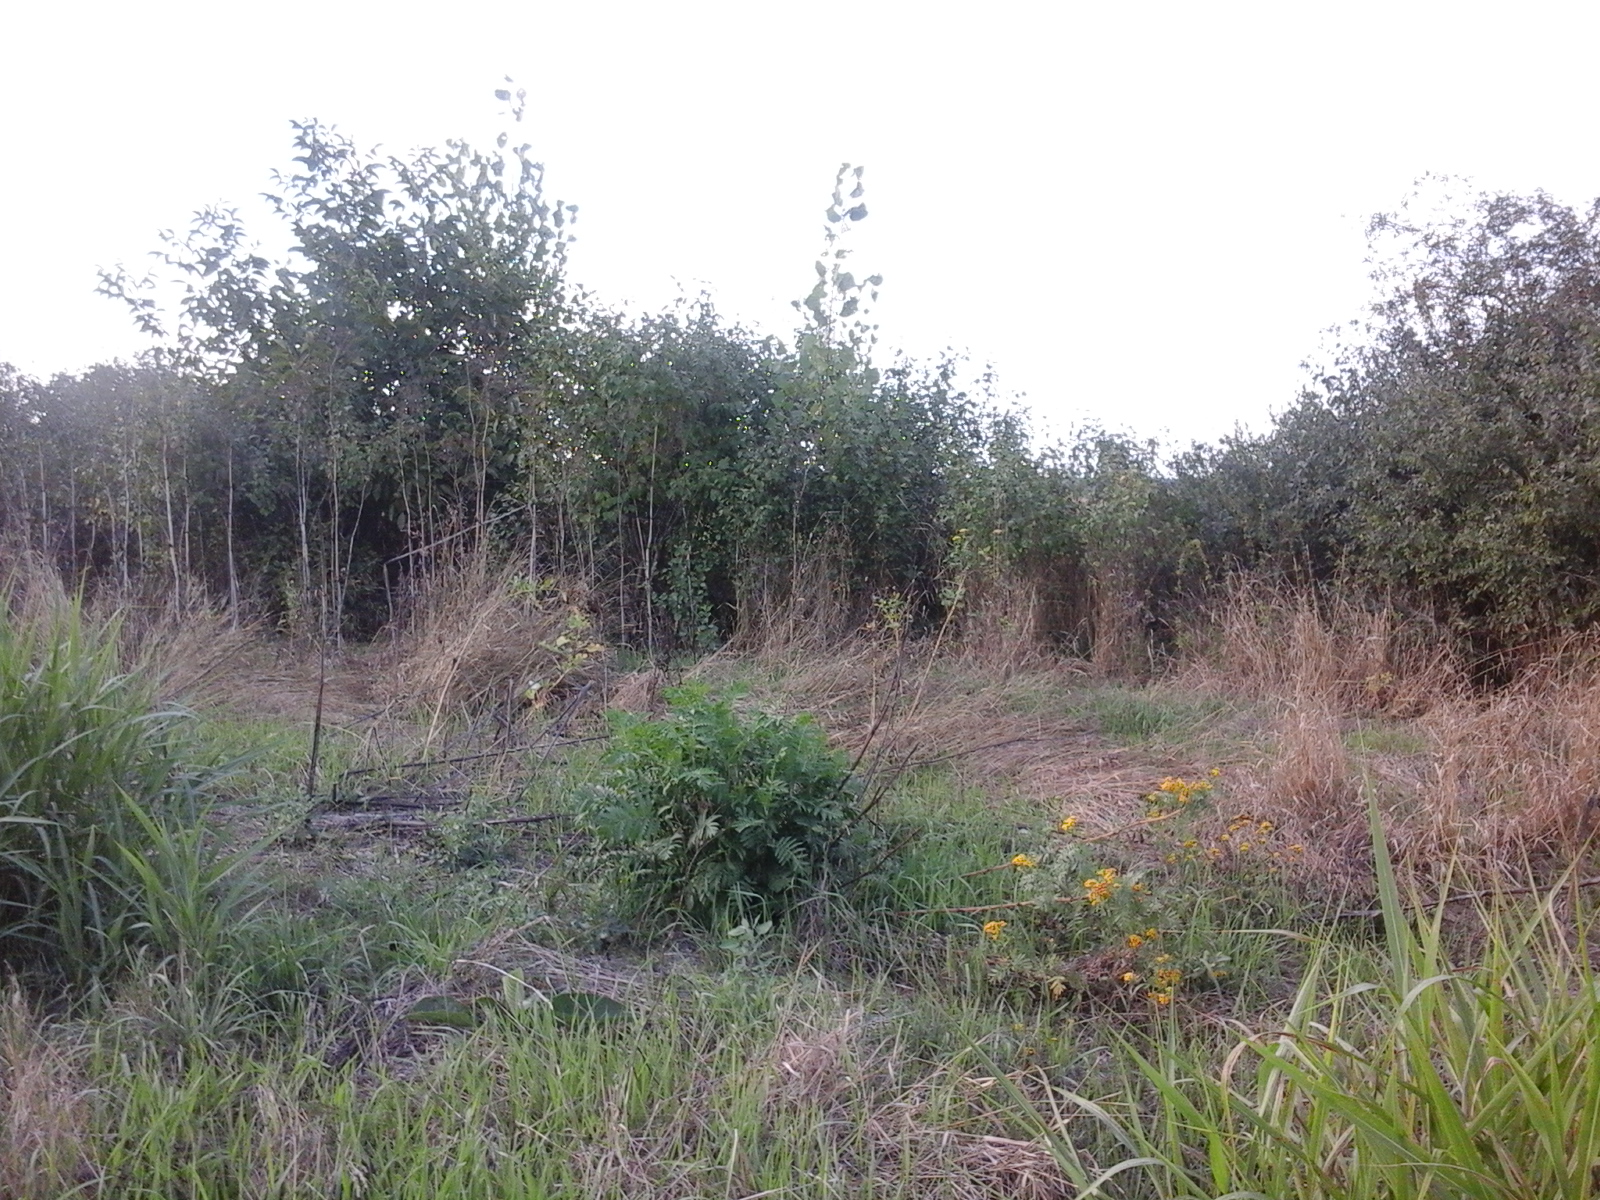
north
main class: Grassland
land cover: Spontaneously vegetated surfaces
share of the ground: > 75 %
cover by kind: herbaceous plants 100 %
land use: Agriculture (excluding fallow land and kitchen gardens)
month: August
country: RO
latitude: 46.4449
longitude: 21.7693
